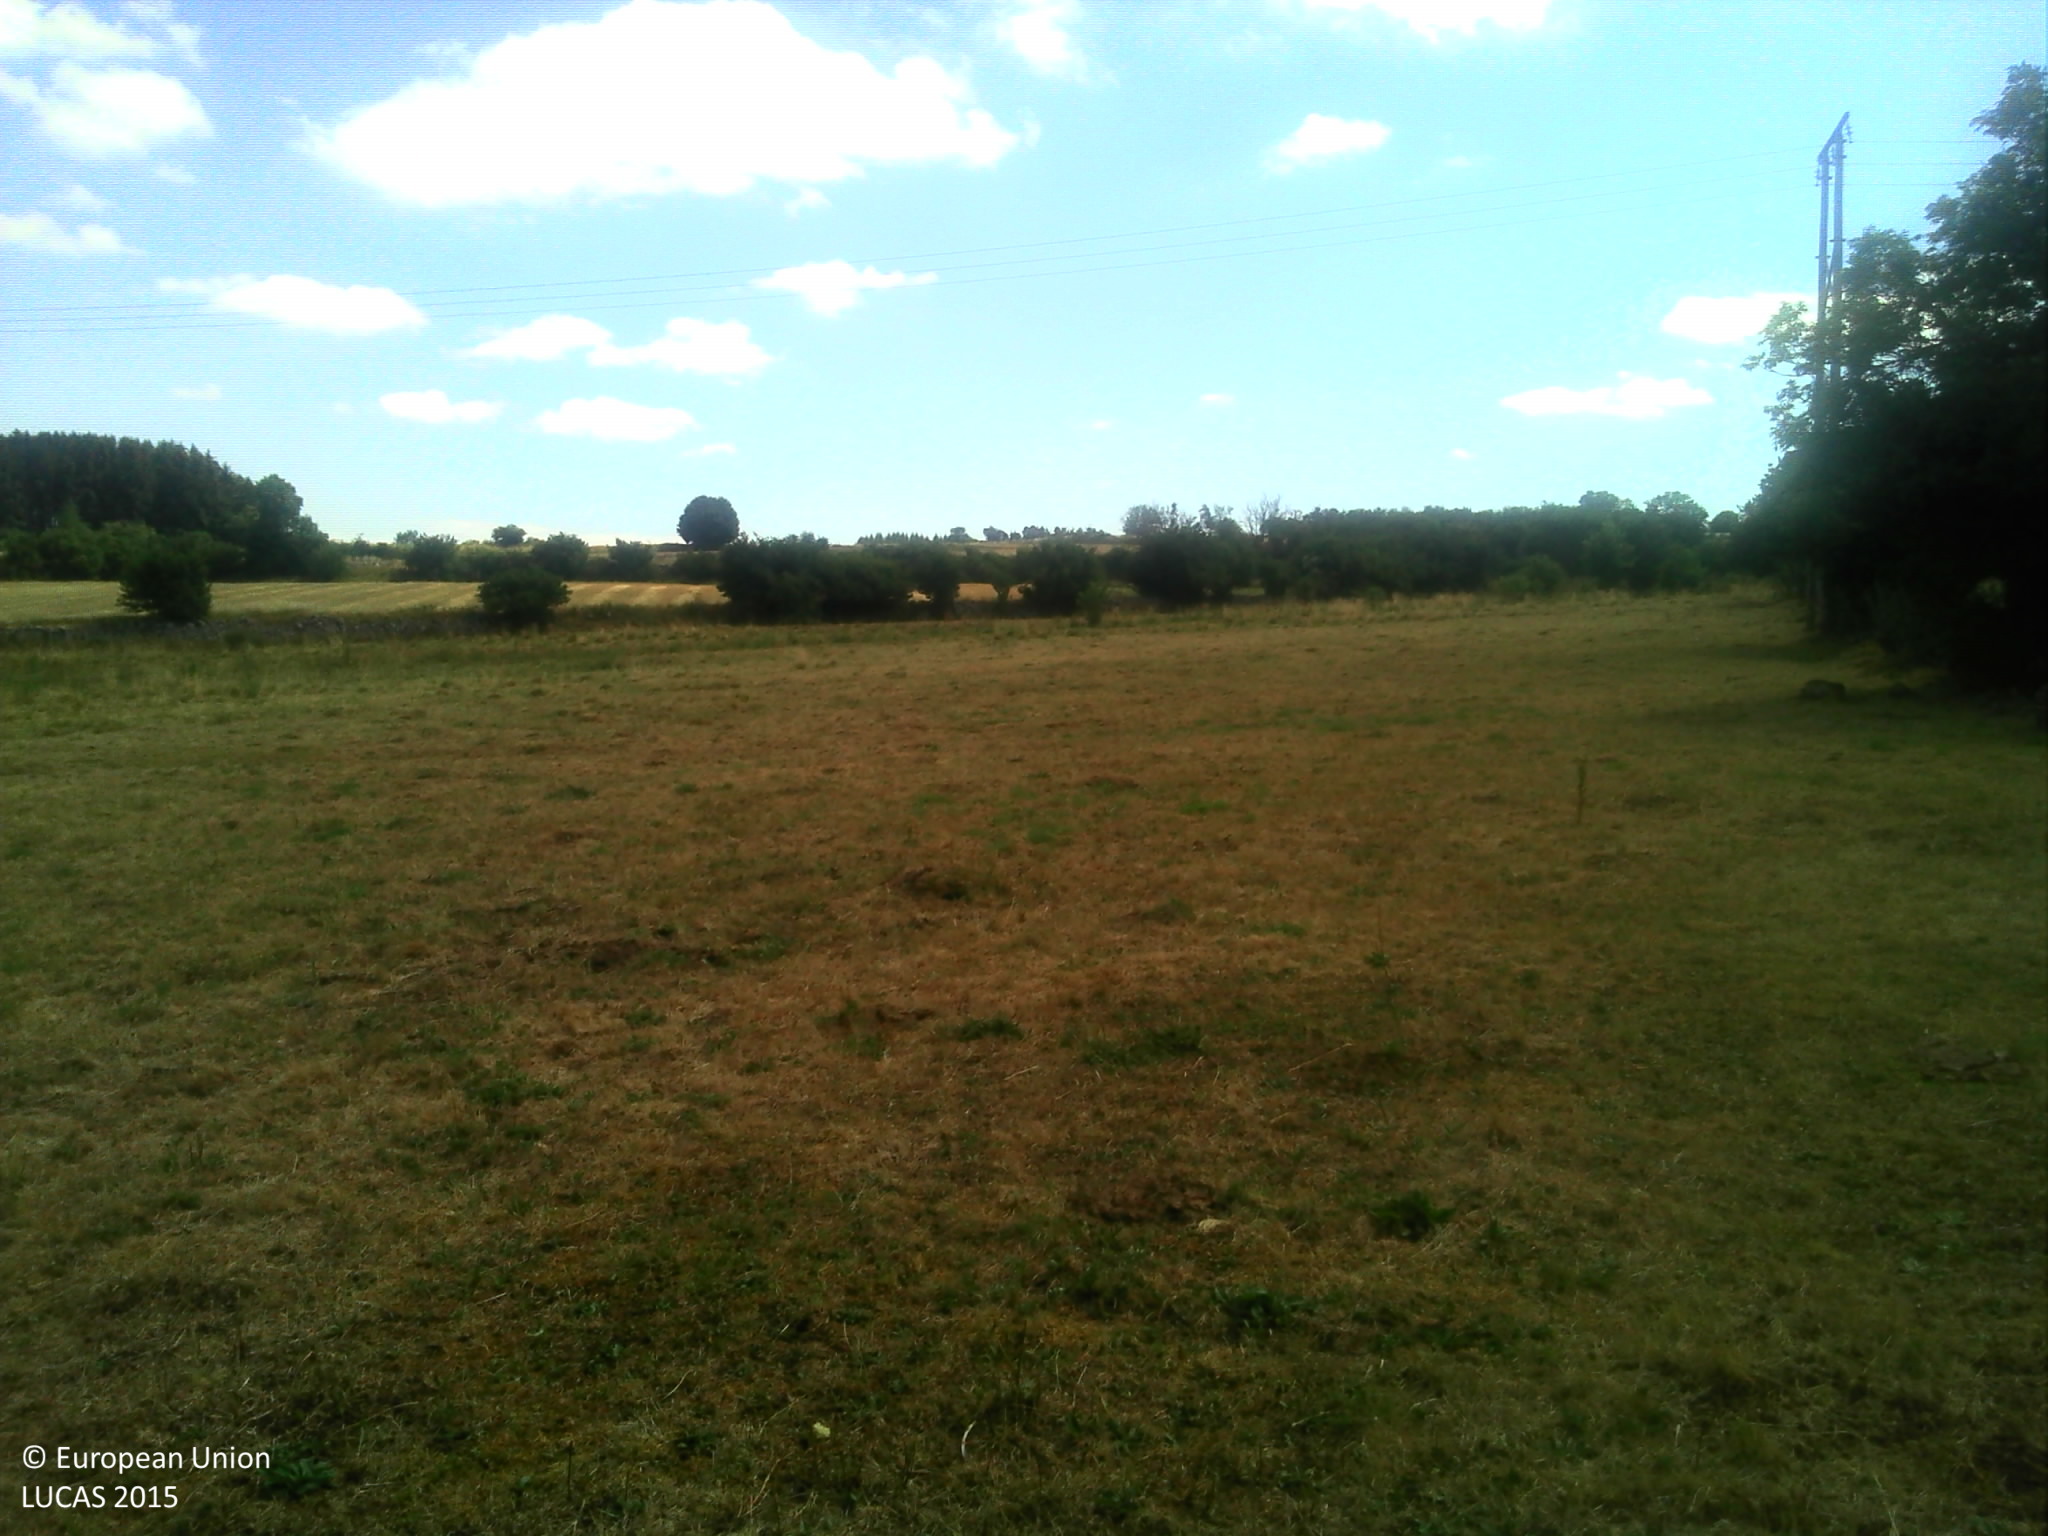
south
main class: Grassland
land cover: Grassland without tree/shrub cover
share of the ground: > 75 %
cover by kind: herbaceous plants 100 %
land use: Agriculture (excluding fallow land and kitchen gardens)
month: July
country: FR
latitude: 44.9265
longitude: 3.8343
